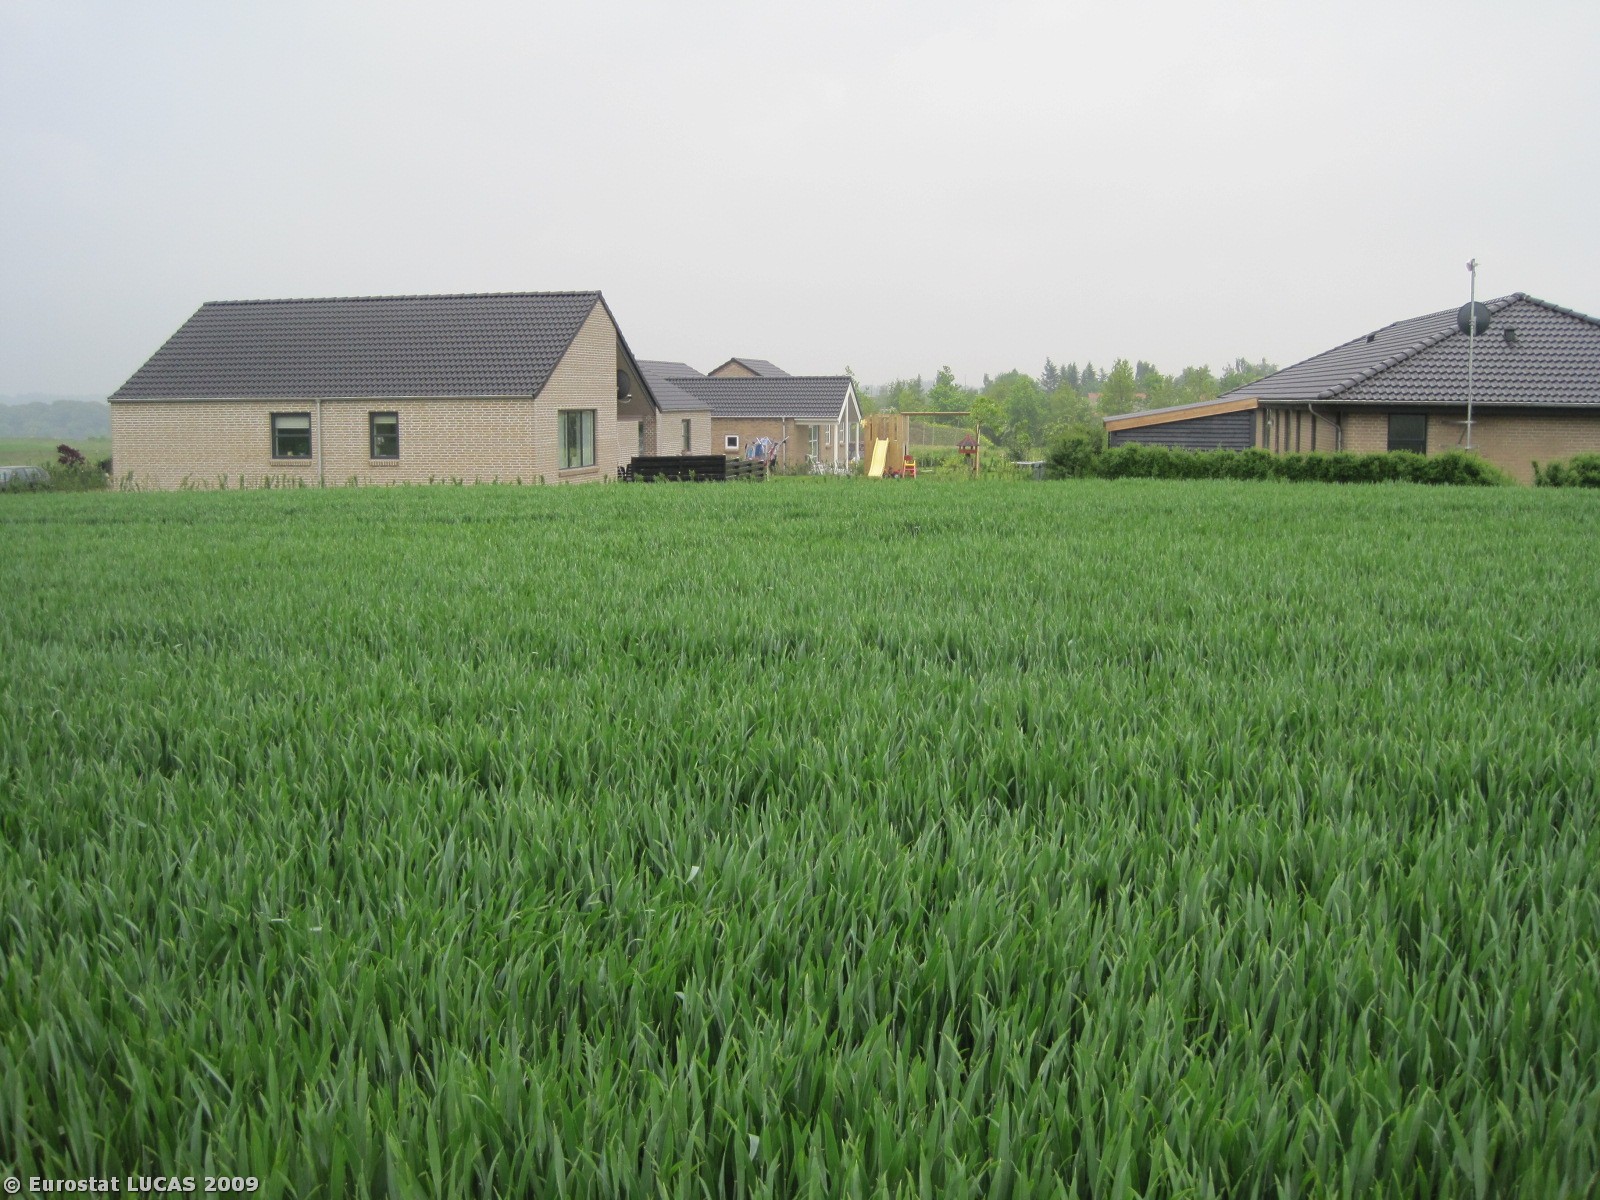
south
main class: Cropland
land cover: Common wheat
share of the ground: > 75 %
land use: Agriculture (excluding fallow land and kitchen gardens)
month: May
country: DK
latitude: 56.4034
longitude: 9.8867
